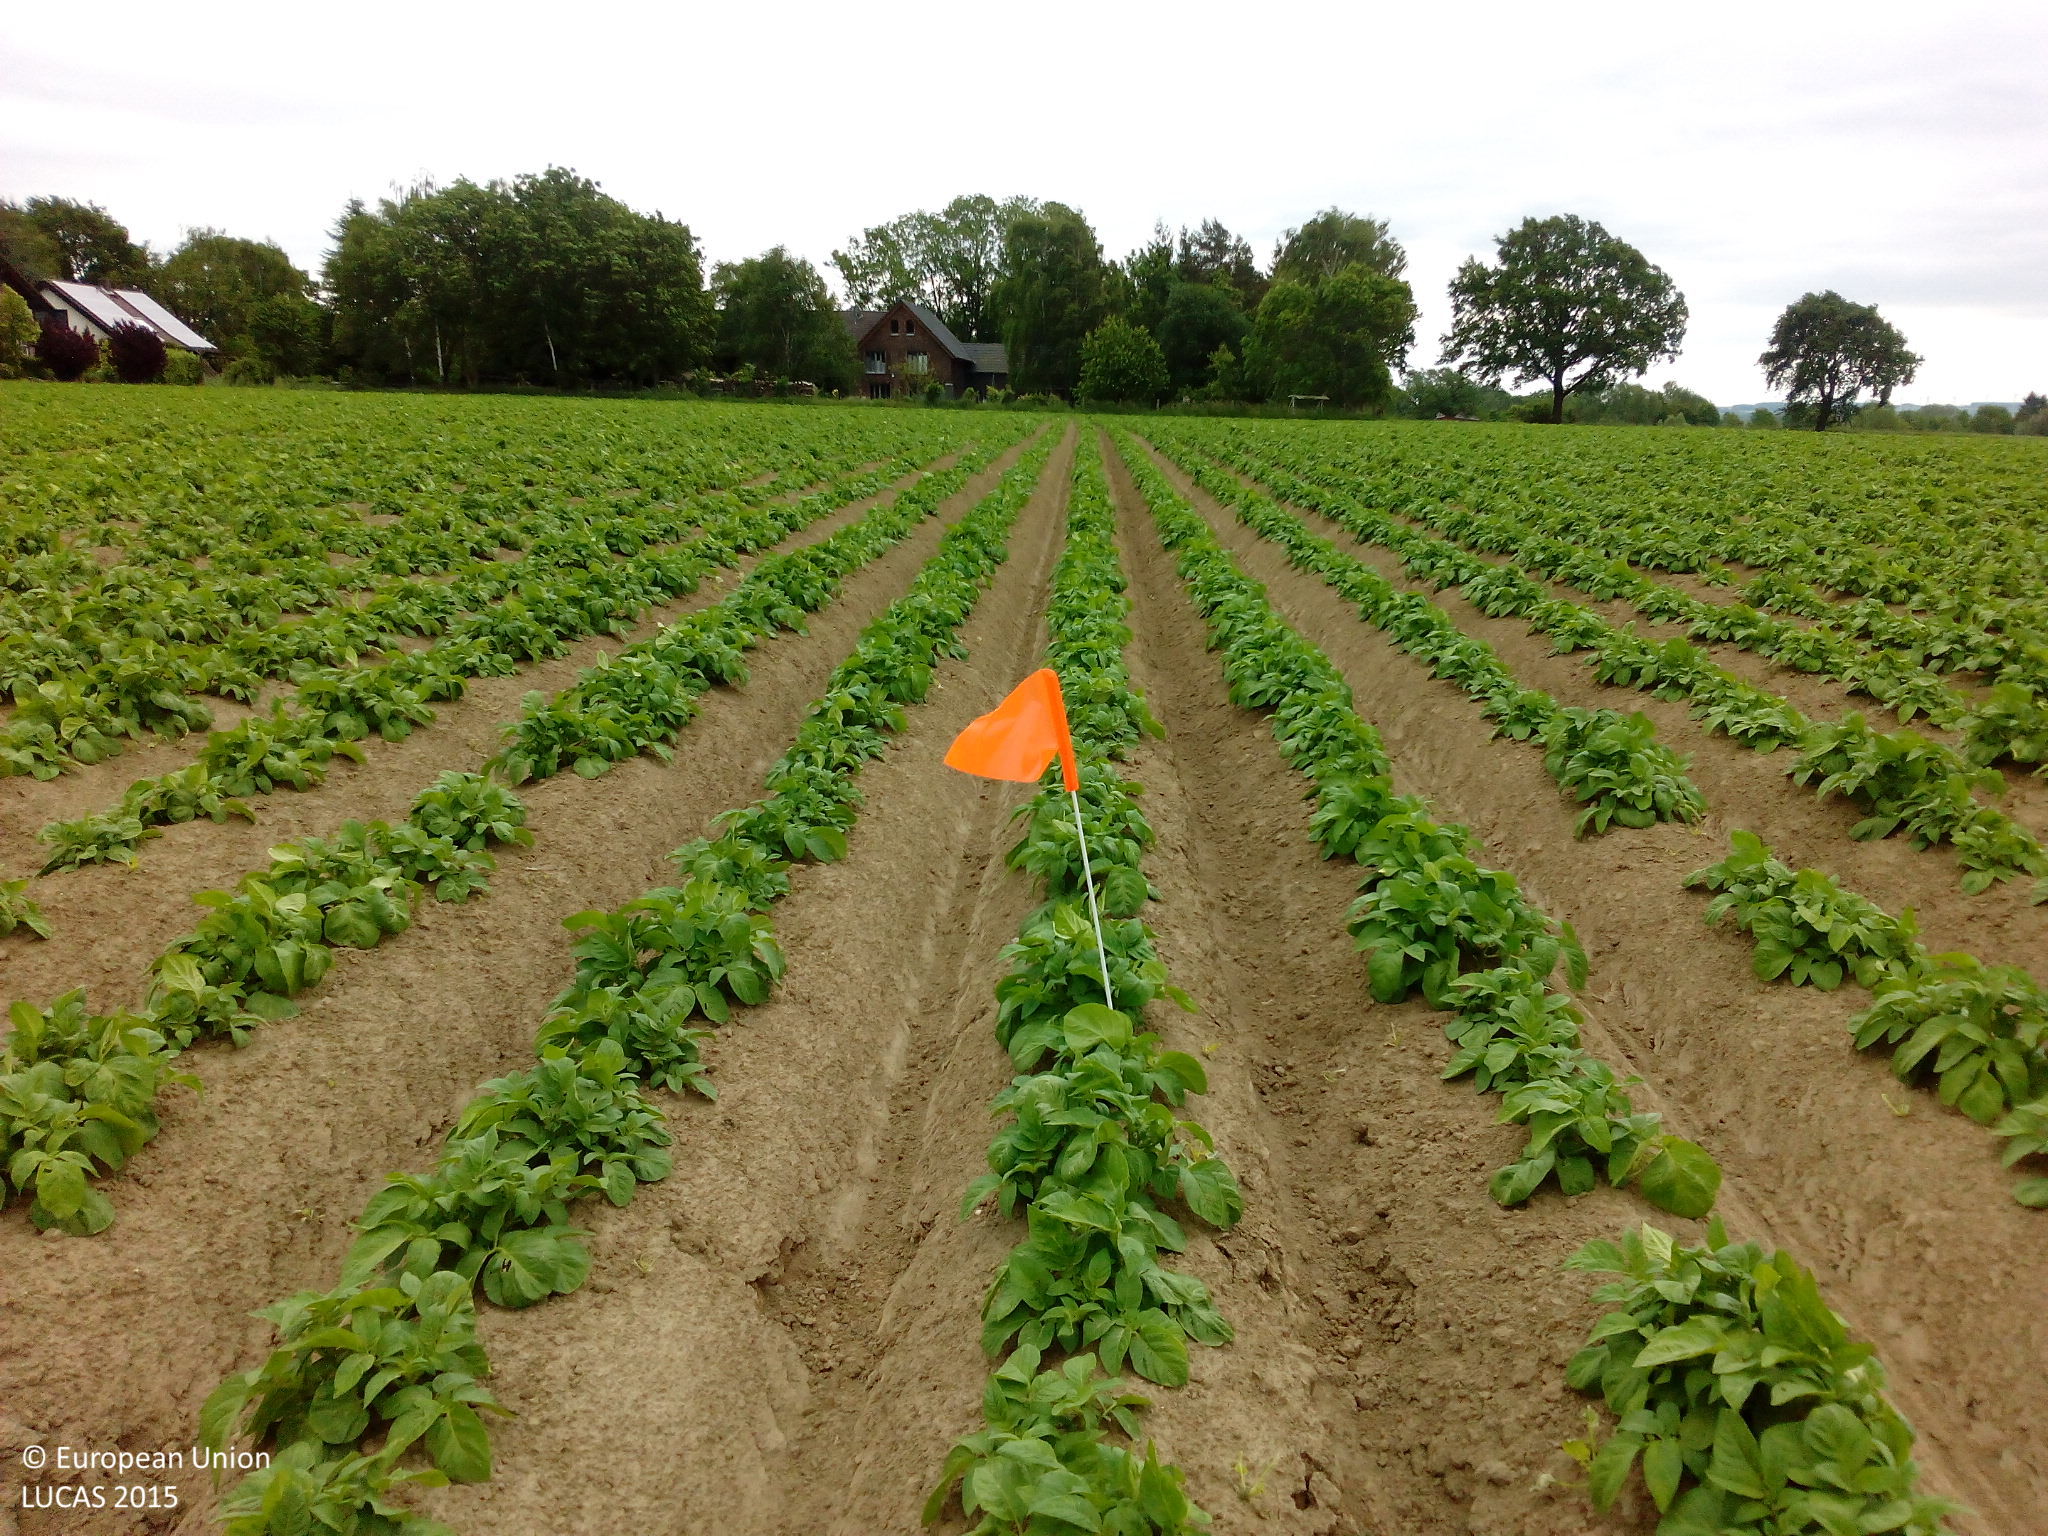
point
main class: Cropland
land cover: Potatoes
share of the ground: 25 - 50 %
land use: Agriculture (excluding fallow land and kitchen gardens)
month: June
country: DE
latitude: 51.5689
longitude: 7.9661
